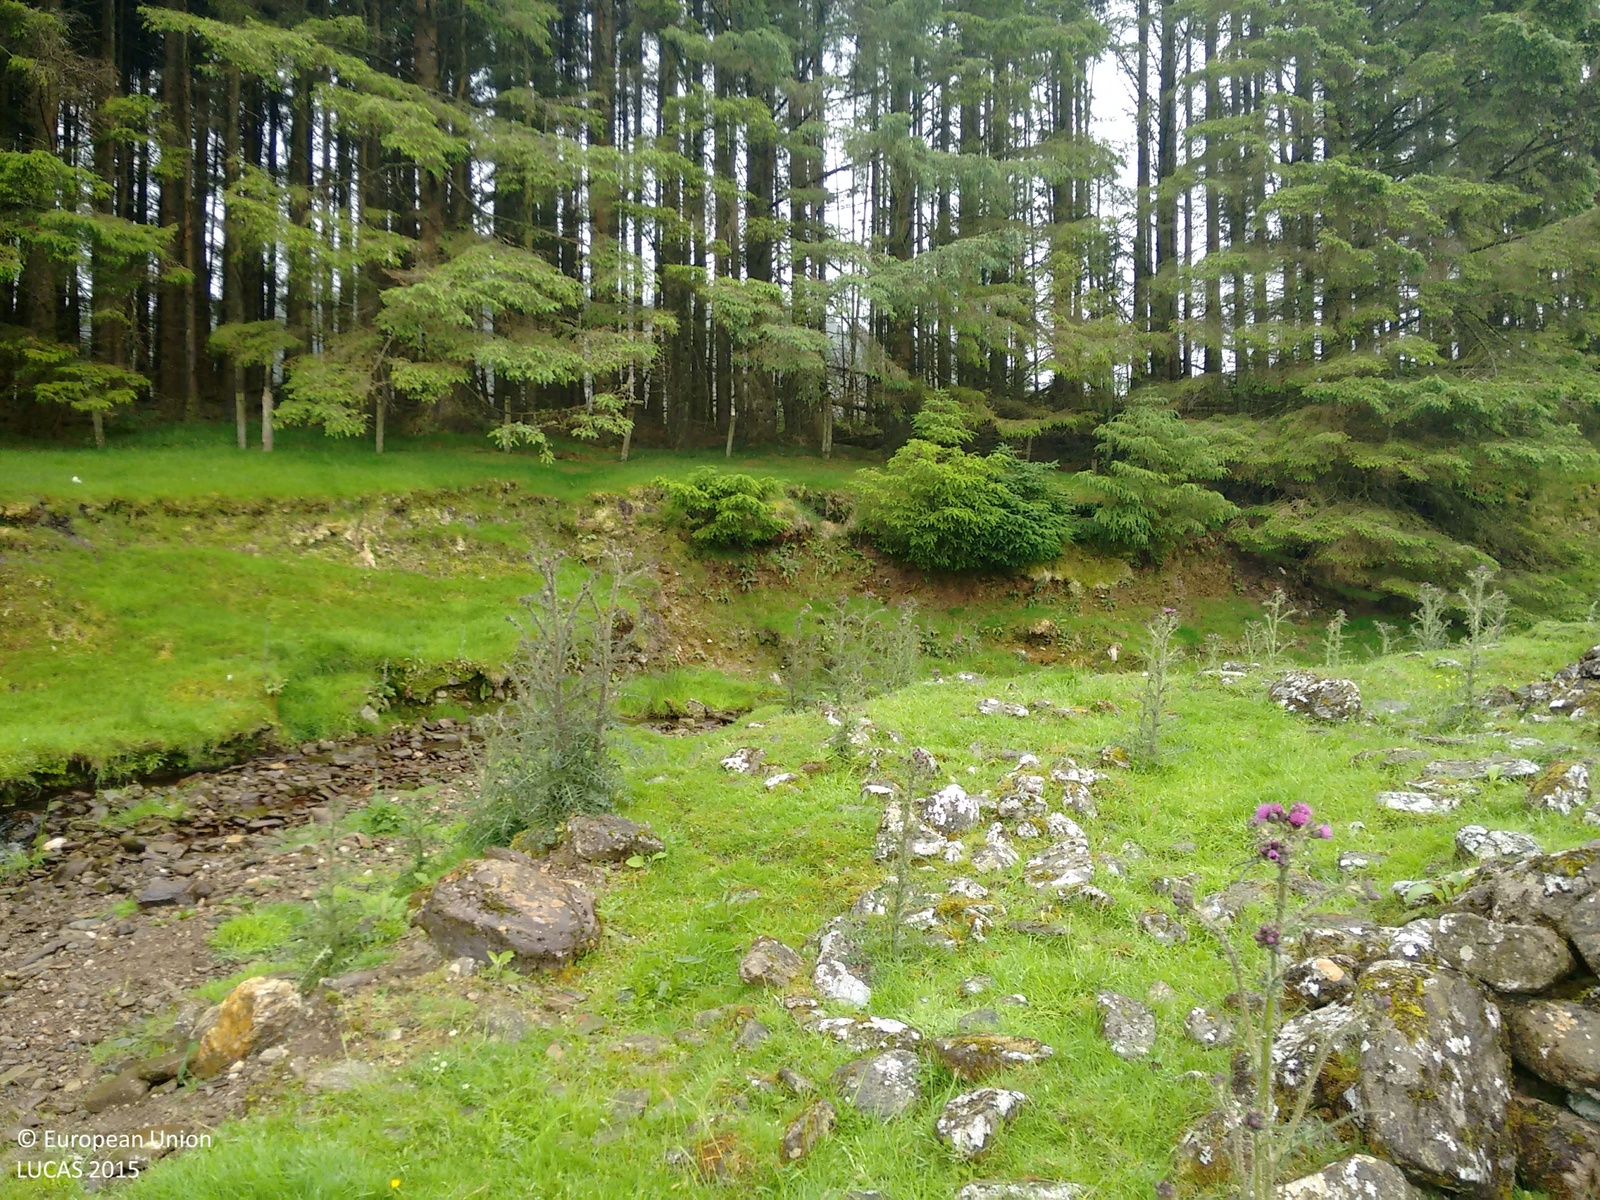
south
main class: Grassland
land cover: Grassland without tree/shrub cover
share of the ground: > 75 %
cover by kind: herbaceous plants 100 %
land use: Agriculture (excluding fallow land and kitchen gardens)
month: July
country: GB
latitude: 54.7897
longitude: -6.9483
